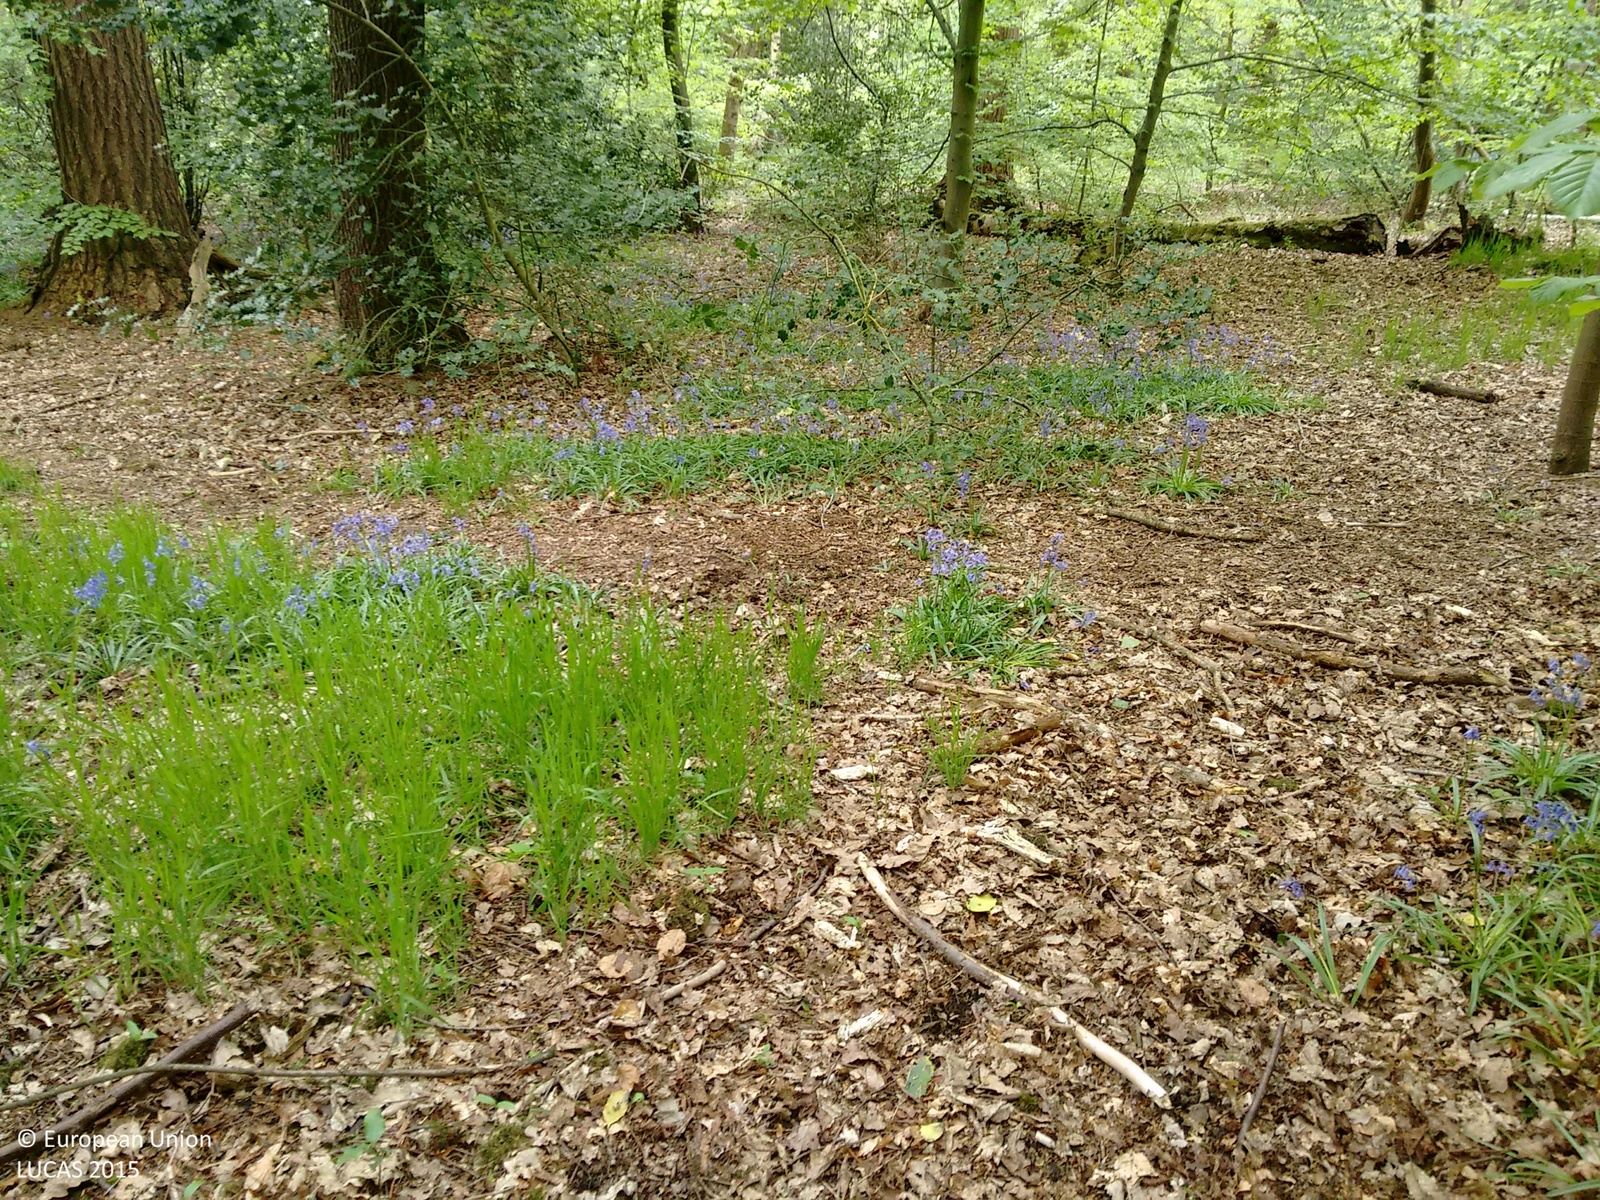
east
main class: Woodland
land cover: Broadleaved woodland
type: mesophytic deciduous forest
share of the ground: > 75 %
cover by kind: broadleaved forest trees 100 %
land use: Semi-natural and natural areas not in use
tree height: > 5 m
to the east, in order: Broadleaved woodland; Rivers and streams; Artificial constructions in urban areas
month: May
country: GB
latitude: 53.3415
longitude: -1.5103
